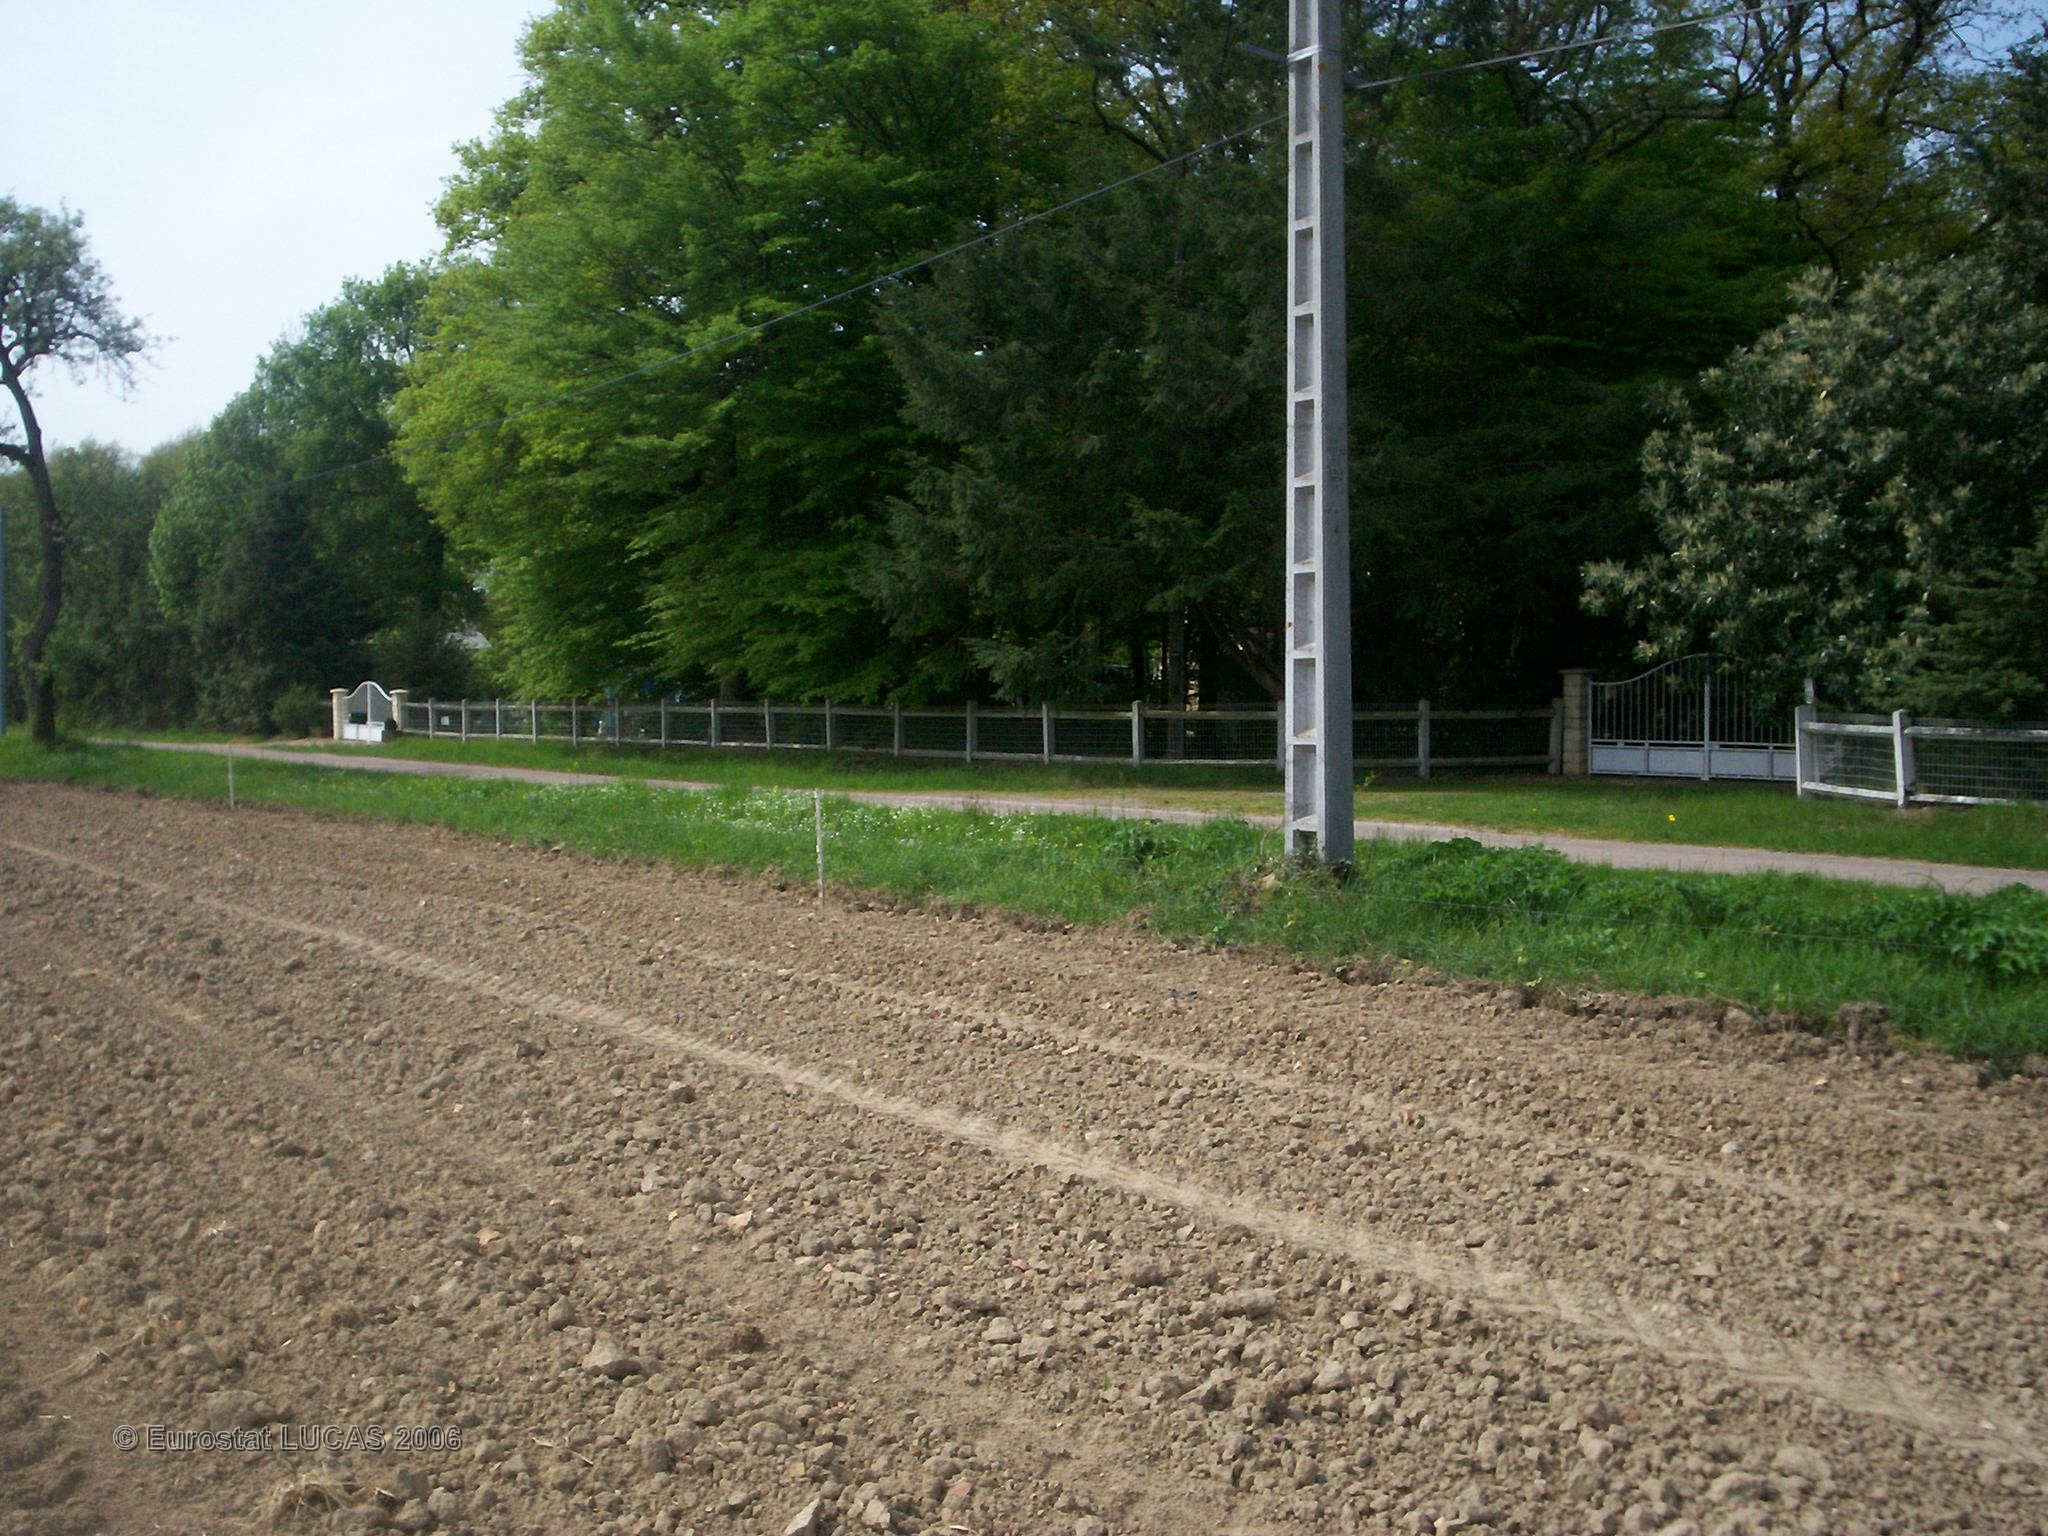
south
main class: Cropland
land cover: Maize
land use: Agriculture (excluding fallow land and kitchen gardens)
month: June
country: FR
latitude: 47.5991
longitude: 2.9313
